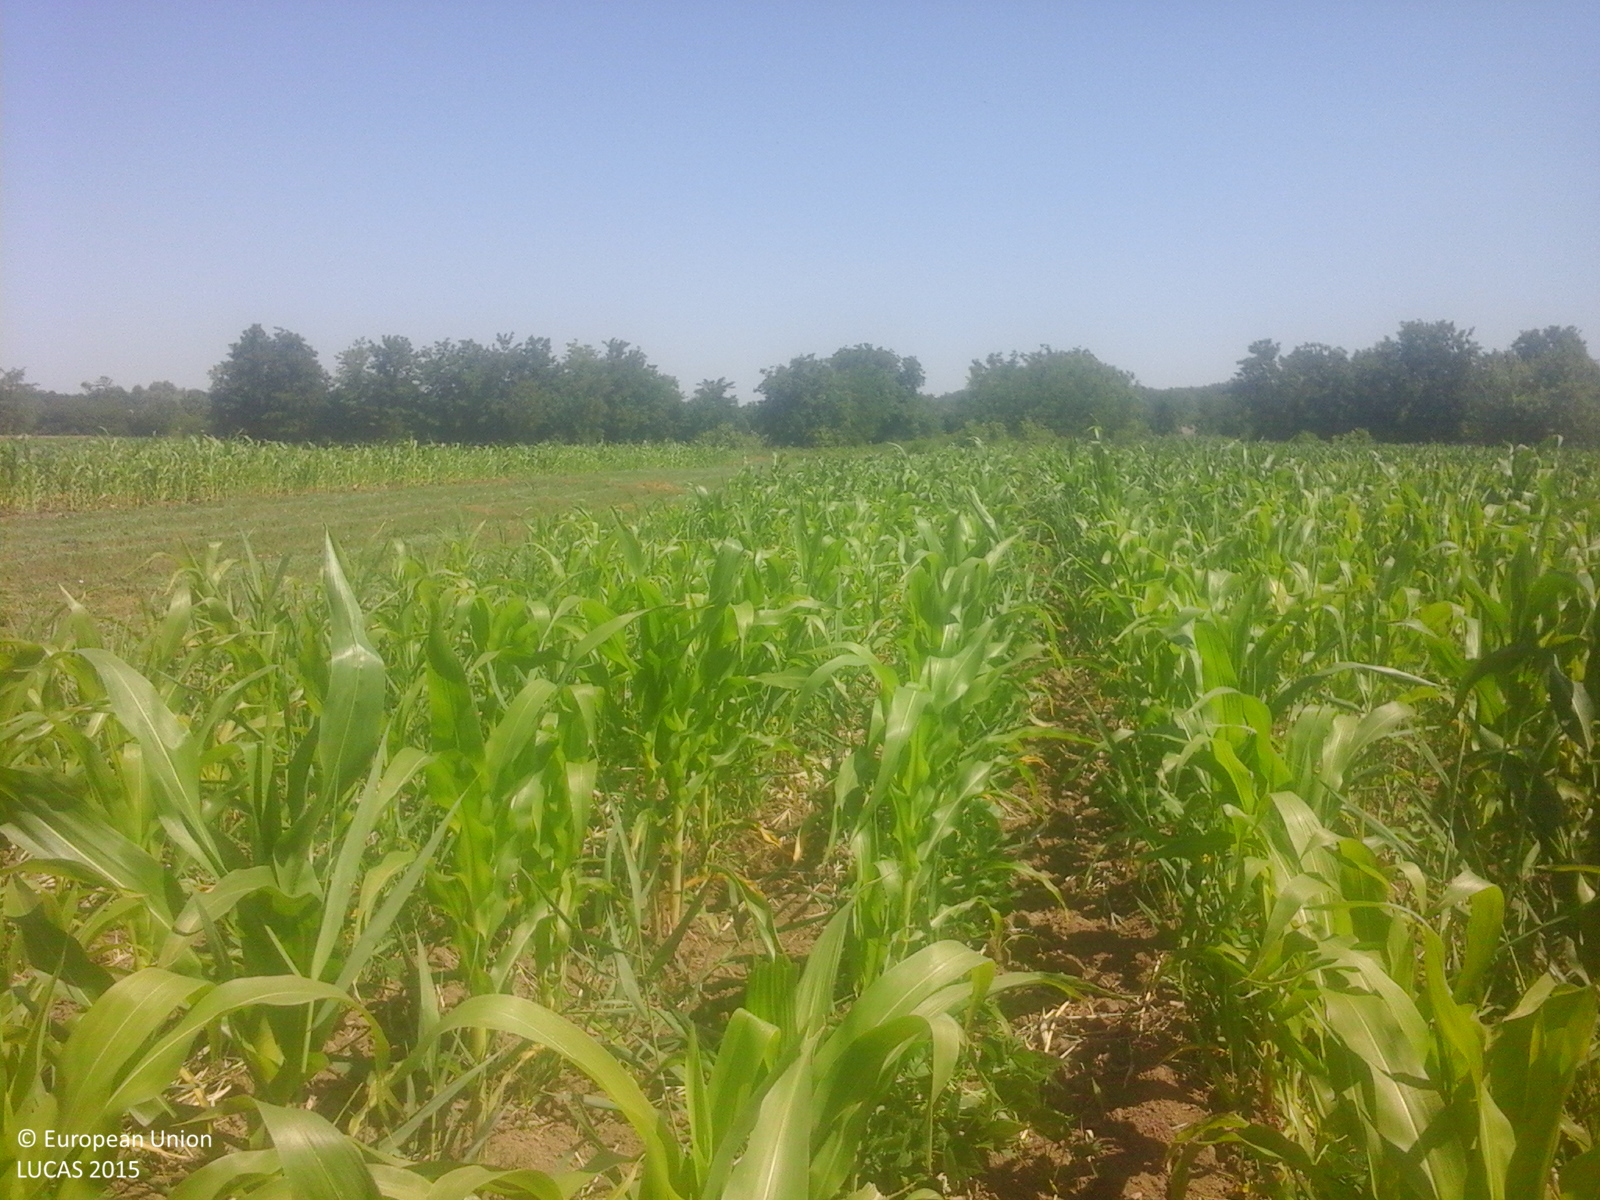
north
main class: Cropland
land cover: Maize
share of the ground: > 75 %
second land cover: Dry pulses
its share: 25 - 50 %
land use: Agriculture (excluding fallow land and kitchen gardens)
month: June
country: RO
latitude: 47.1011
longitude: 27.8480
